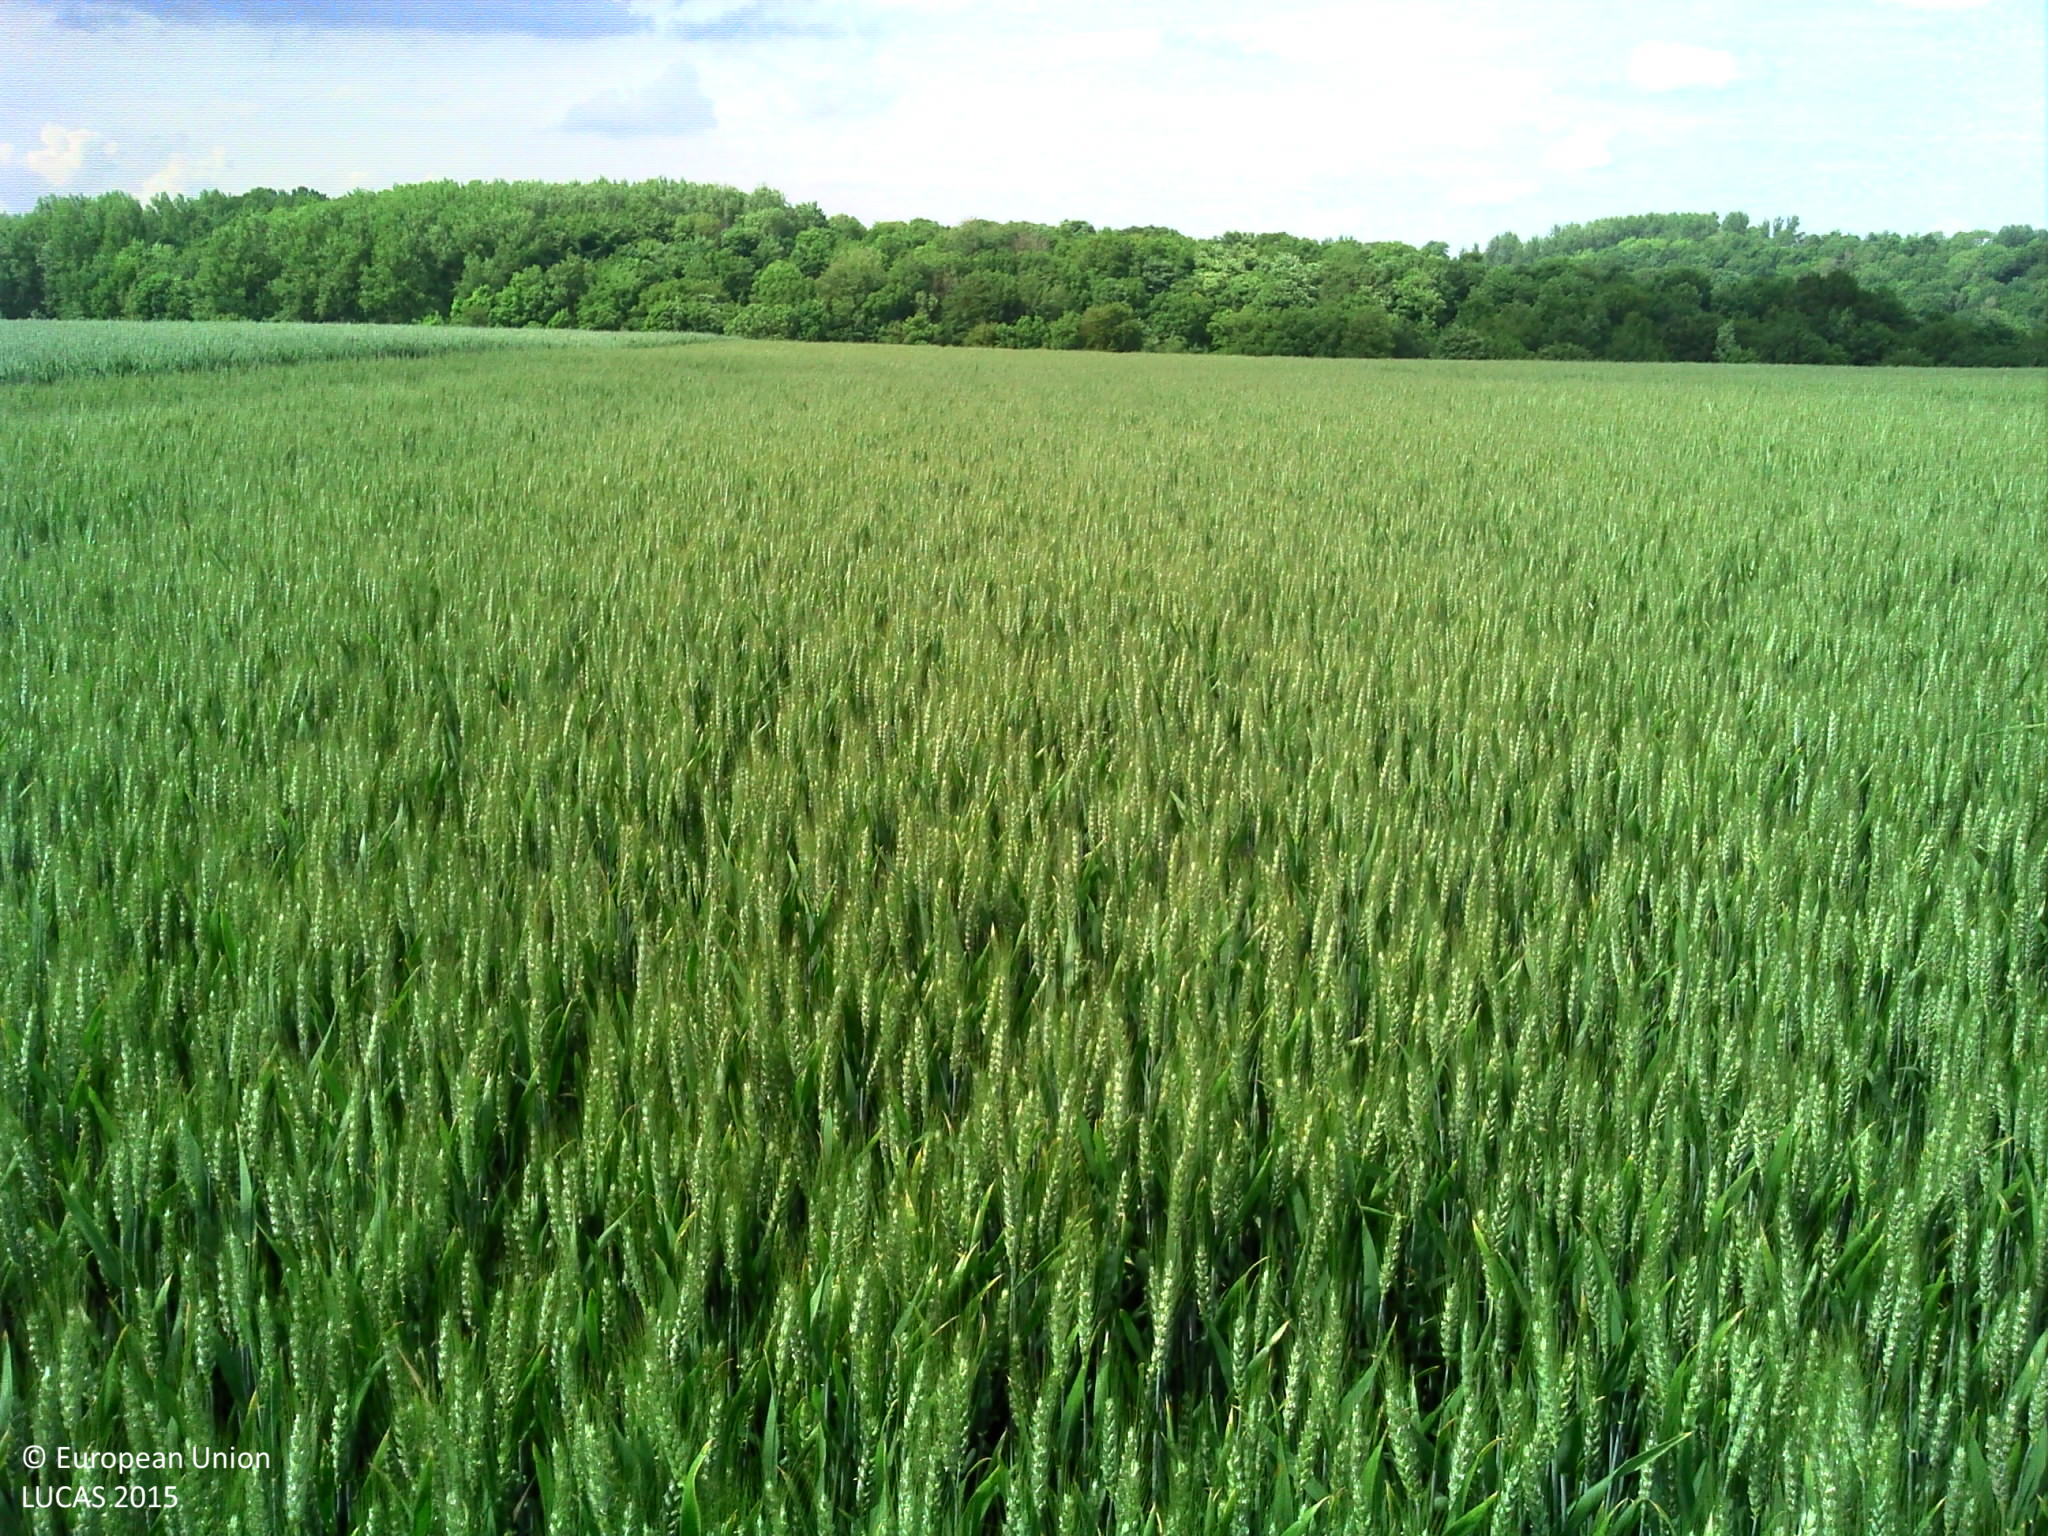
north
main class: Cropland
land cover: Common wheat
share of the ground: > 75 %
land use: Agriculture (excluding fallow land and kitchen gardens)
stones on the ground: 10 - 25 %
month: June
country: FR
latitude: 50.4877
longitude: 2.3613
